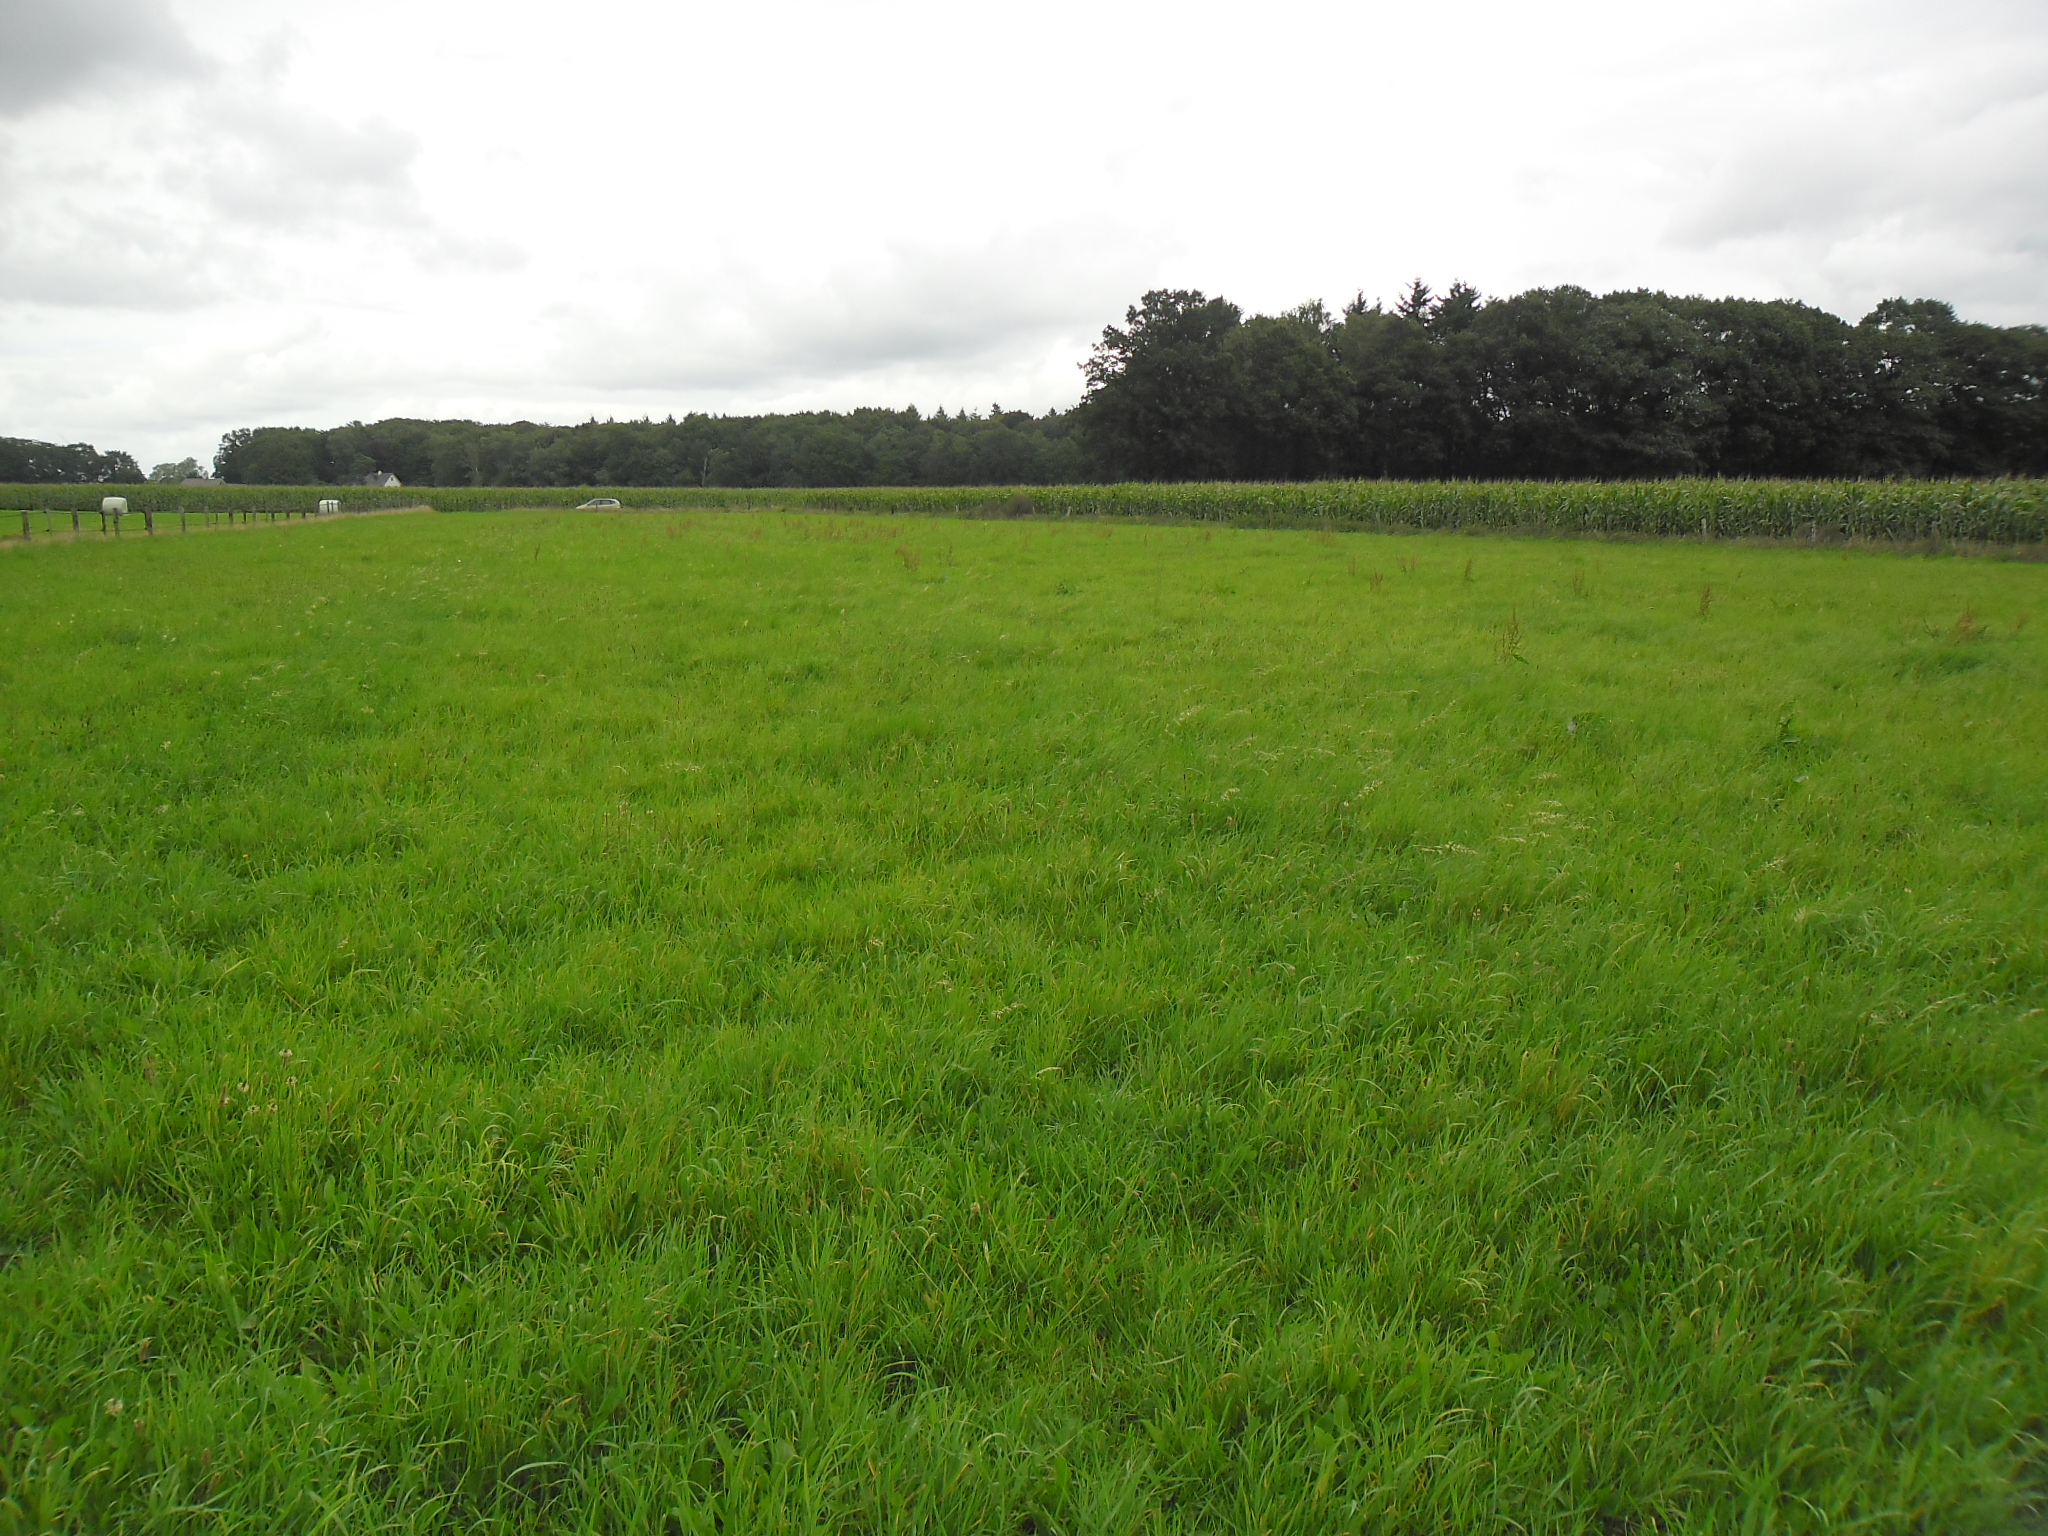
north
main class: Grassland
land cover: Grassland without tree/shrub cover
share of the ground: > 75 %
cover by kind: herbaceous plants 100 %
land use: Agriculture (excluding fallow land and kitchen gardens)
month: September
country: NL
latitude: 52.2090
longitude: 6.2091
